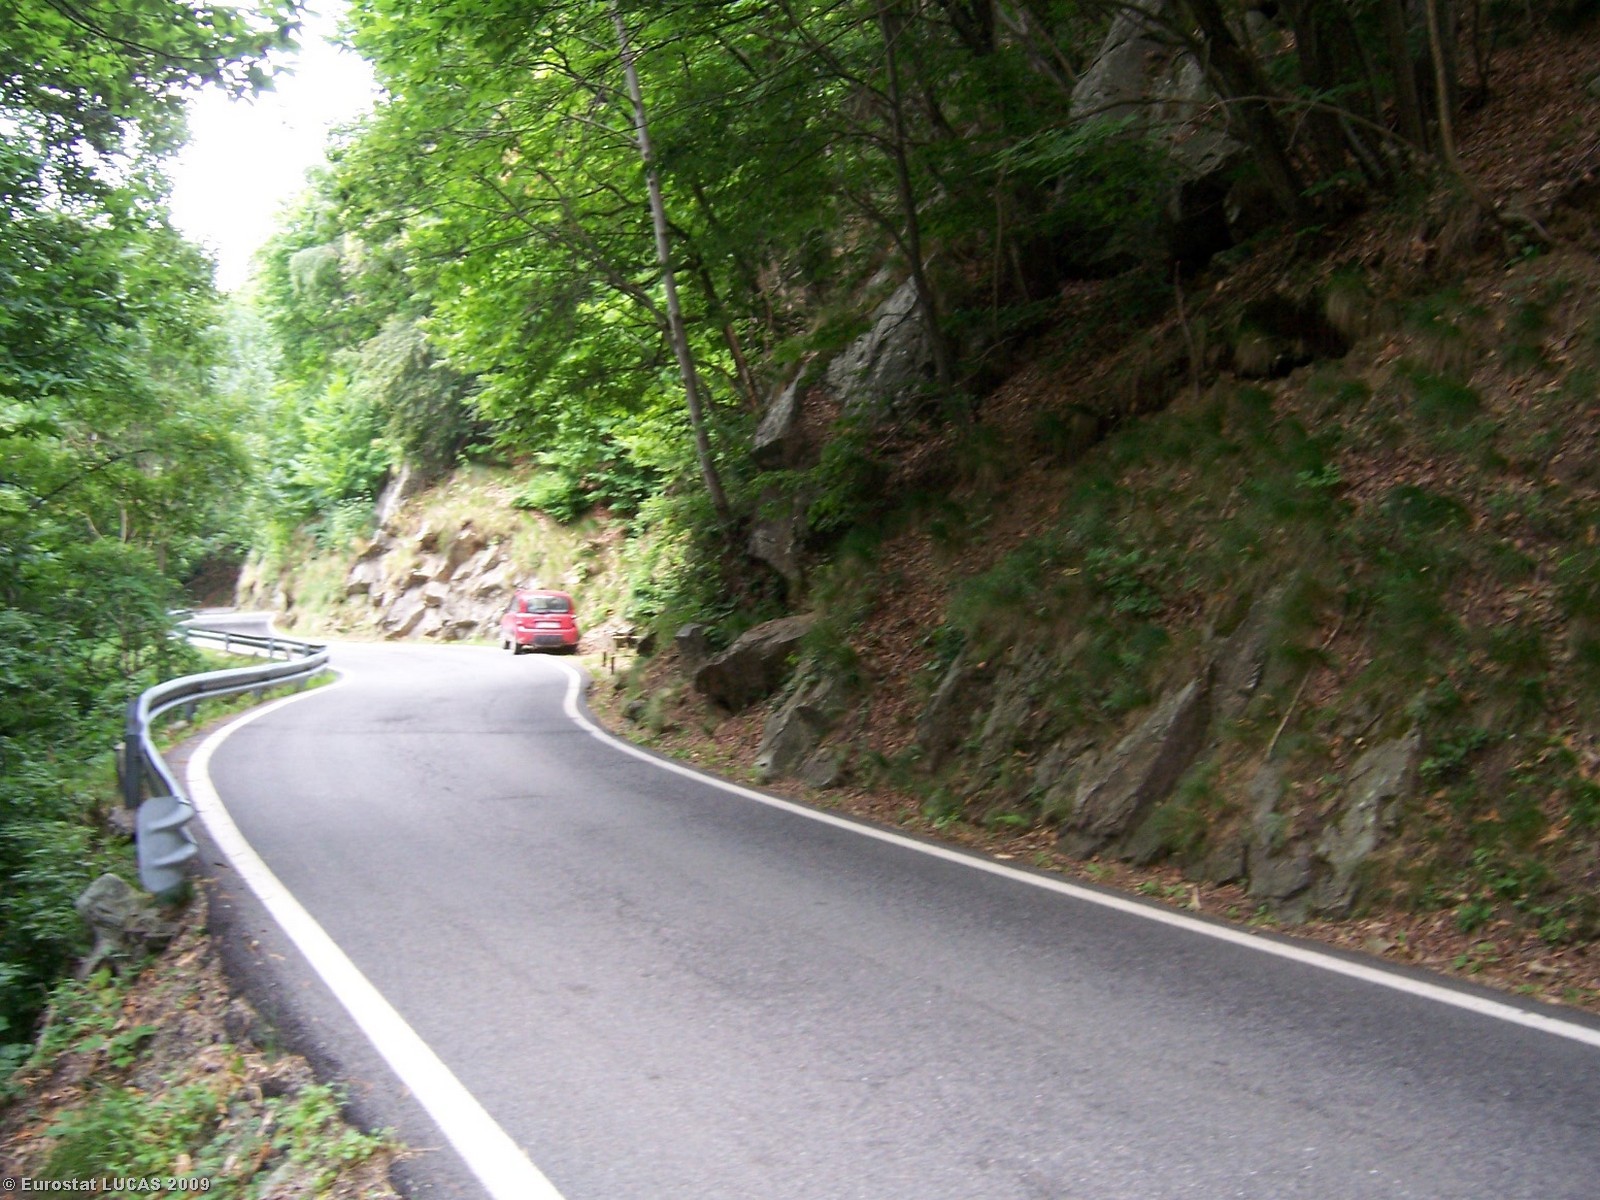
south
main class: Woodland
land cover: Broadleaved woodland
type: mesophytic deciduous forest
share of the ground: > 75 %
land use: Forestry
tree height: > 5 m
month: July
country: IT
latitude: 45.1651
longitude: 7.3708
